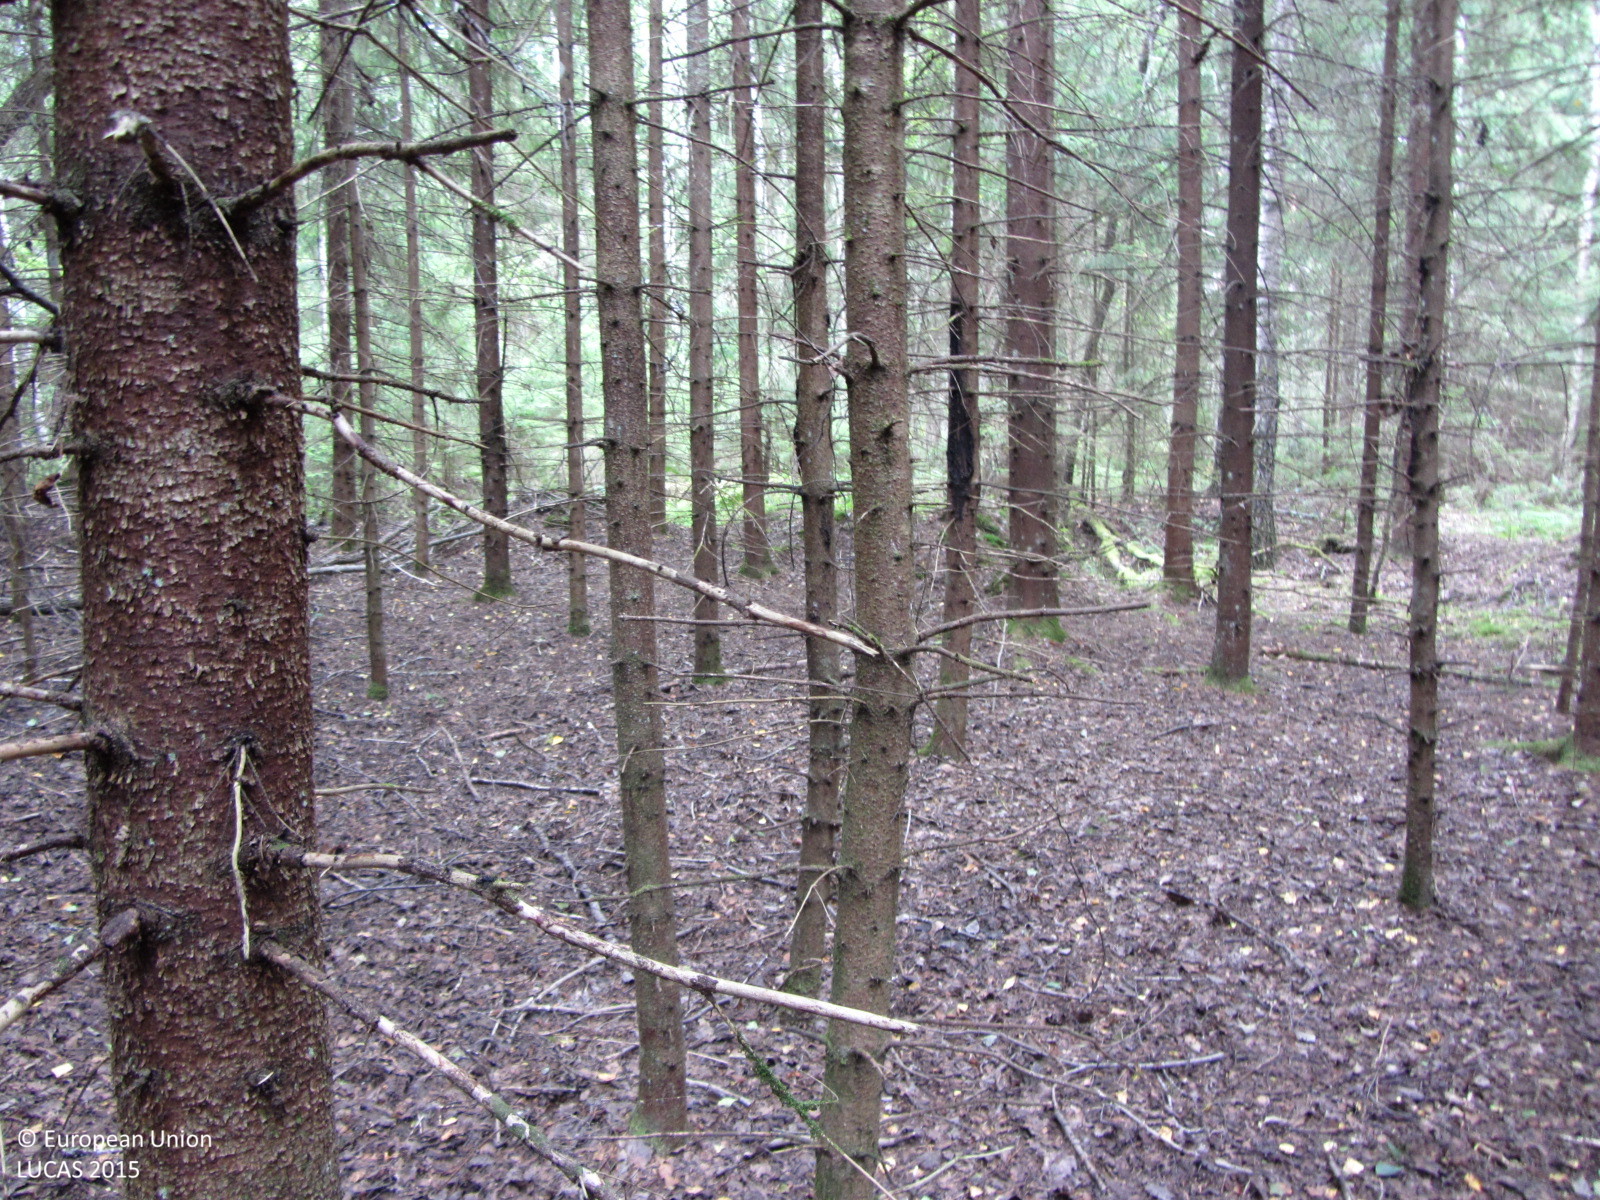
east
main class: Woodland
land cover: Spruce dominated mixed woodland
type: boreal forest
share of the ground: > 75 %
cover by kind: coniferous forest trees 70 %, broadleaved forest trees 30 %
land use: Forestry
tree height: > 5 m
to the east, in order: Spruce dominated mixed woodland; Ditches and canals; Spruce dominated coniferous woodland; Spruce dominated mixed woodland; Spruce dominated coniferous woodland
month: August
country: FI
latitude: 60.2835
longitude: 23.8207
